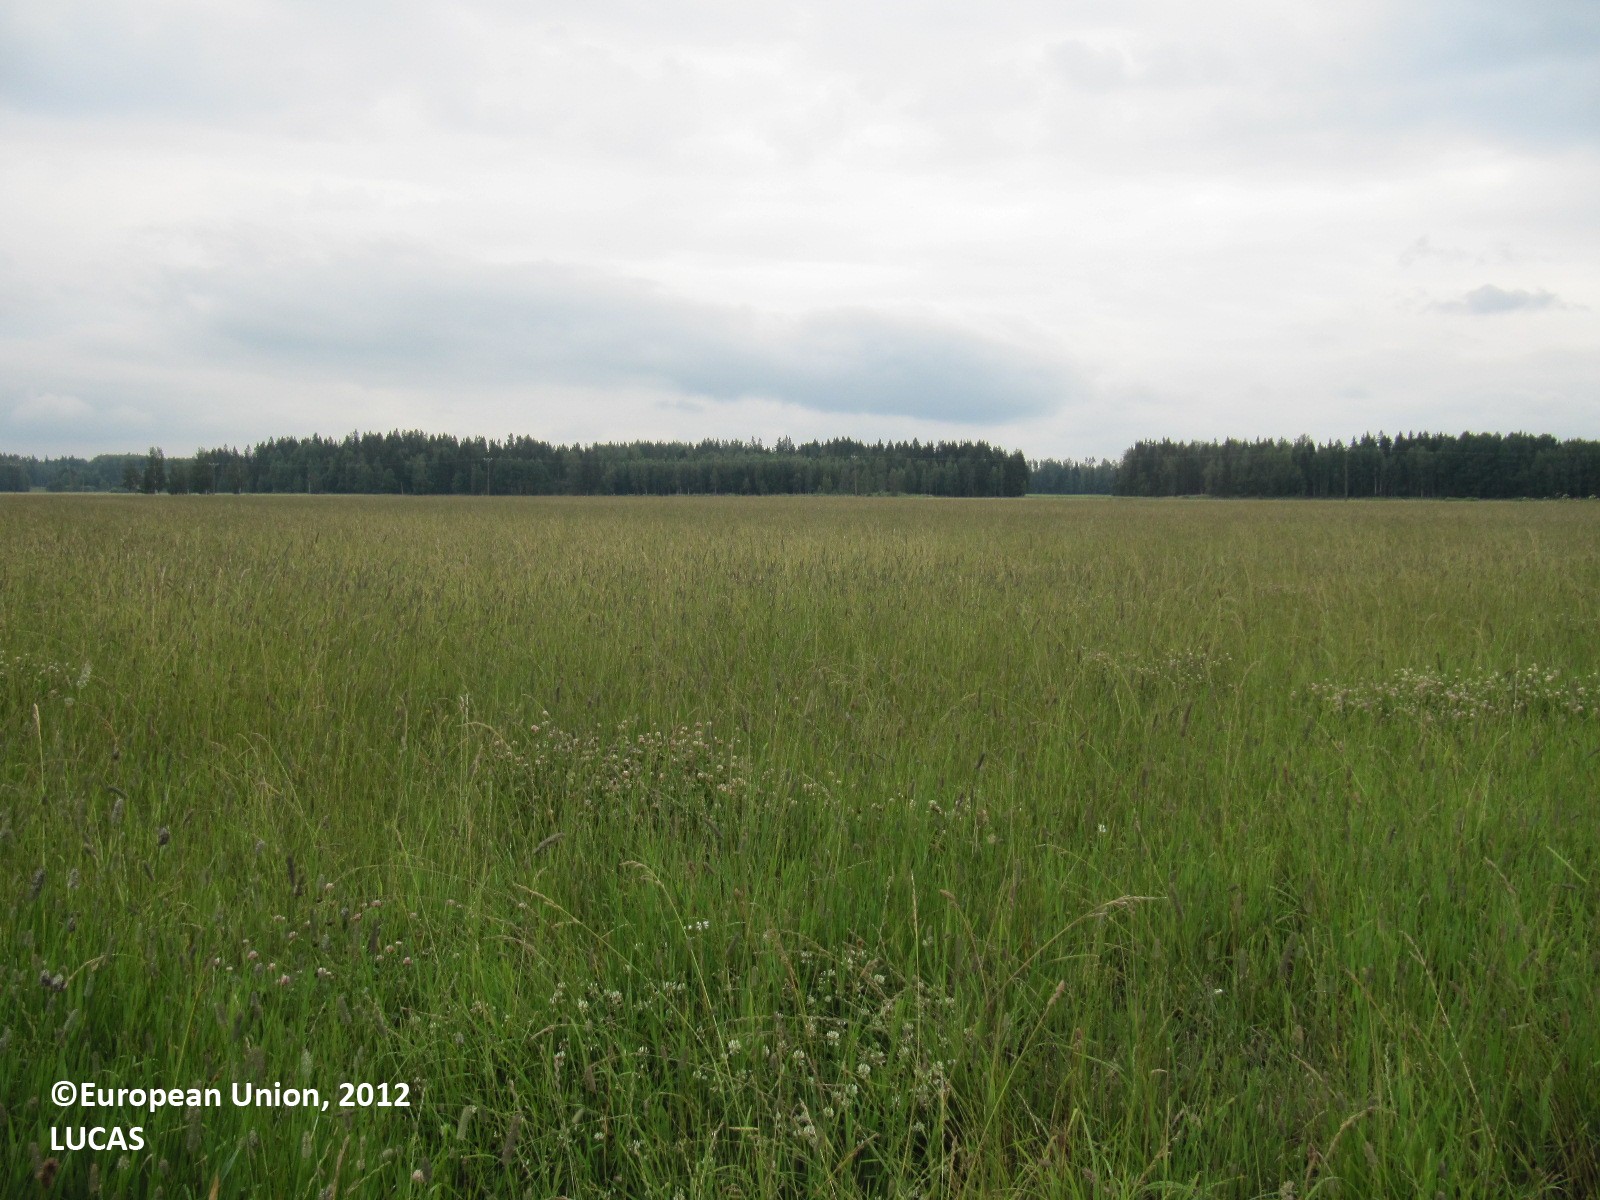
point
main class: Cropland
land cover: Temporary grasslands
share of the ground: > 75 %
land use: Agriculture (excluding fallow land and kitchen gardens)
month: July
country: FI
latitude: 60.7328
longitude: 23.3400
